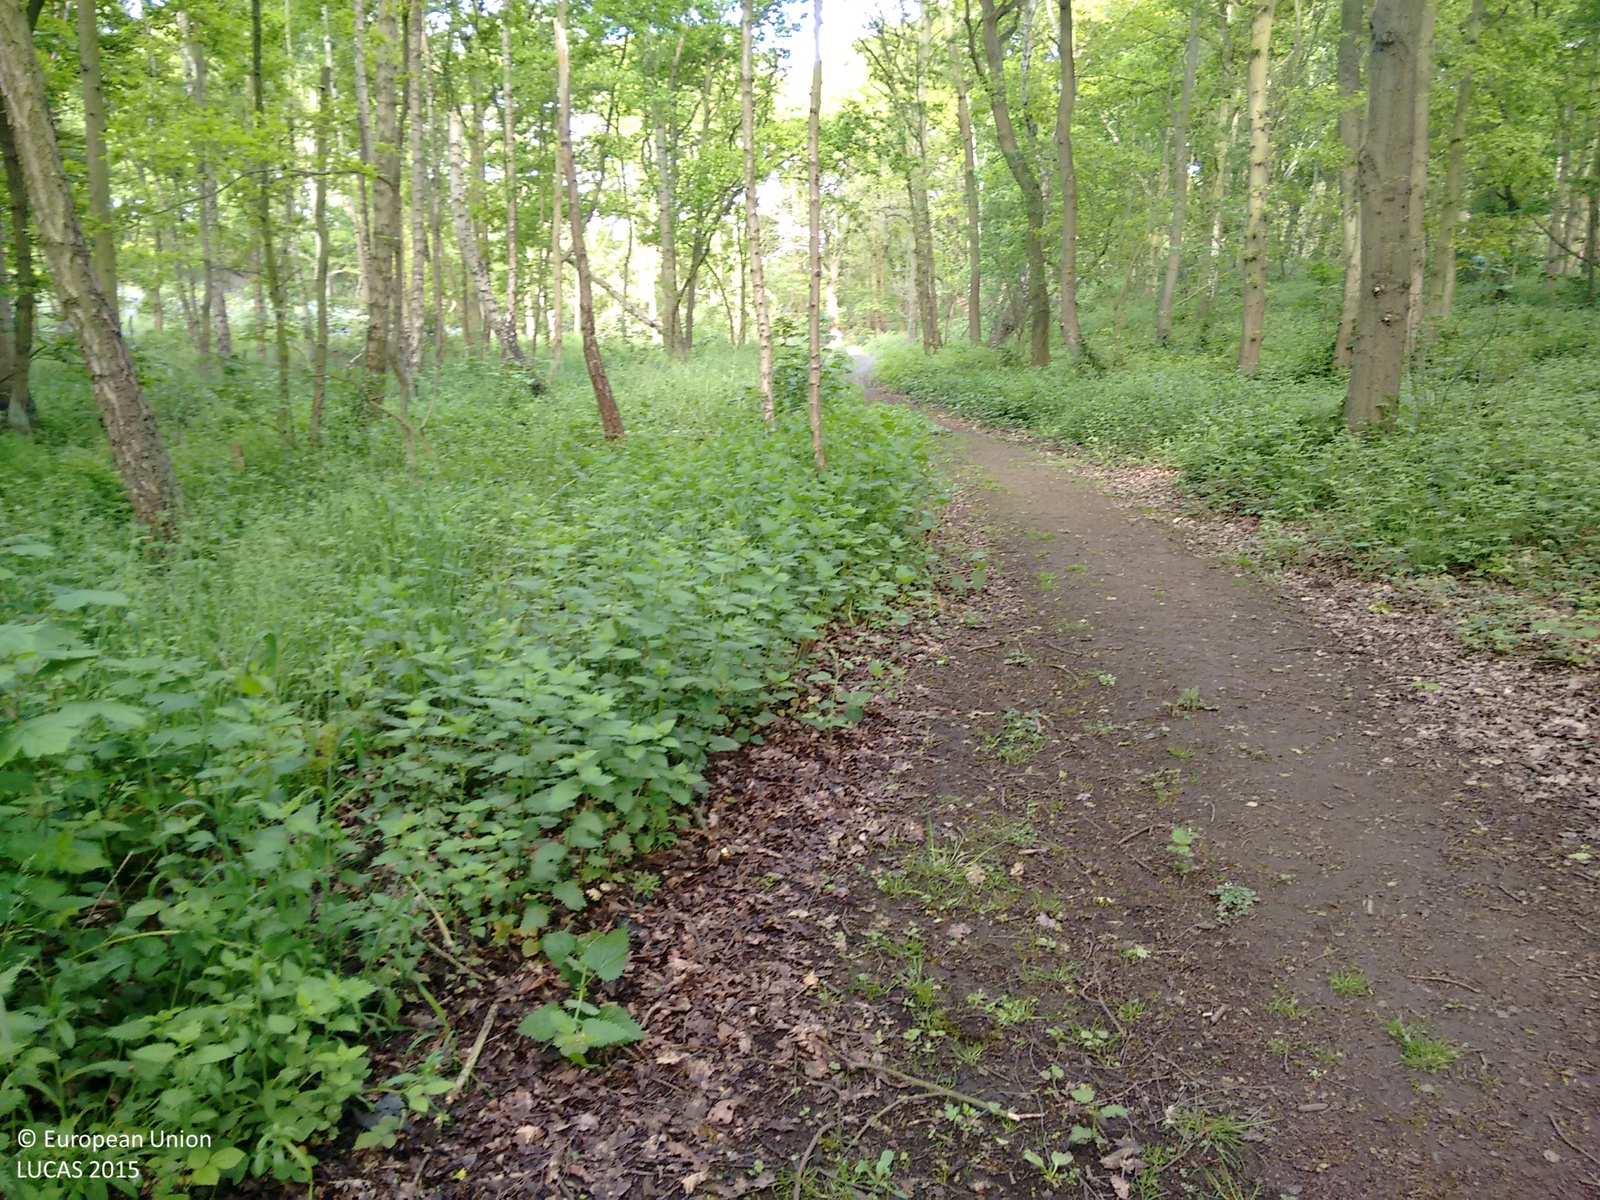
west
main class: Woodland
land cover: Broadleaved woodland
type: mesophytic deciduous forest
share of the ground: > 75 %
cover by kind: broadleaved forest trees 100 %
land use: Amenities, museums, leisure
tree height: > 5 m
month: May
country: GB
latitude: 53.4420
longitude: -1.0187
